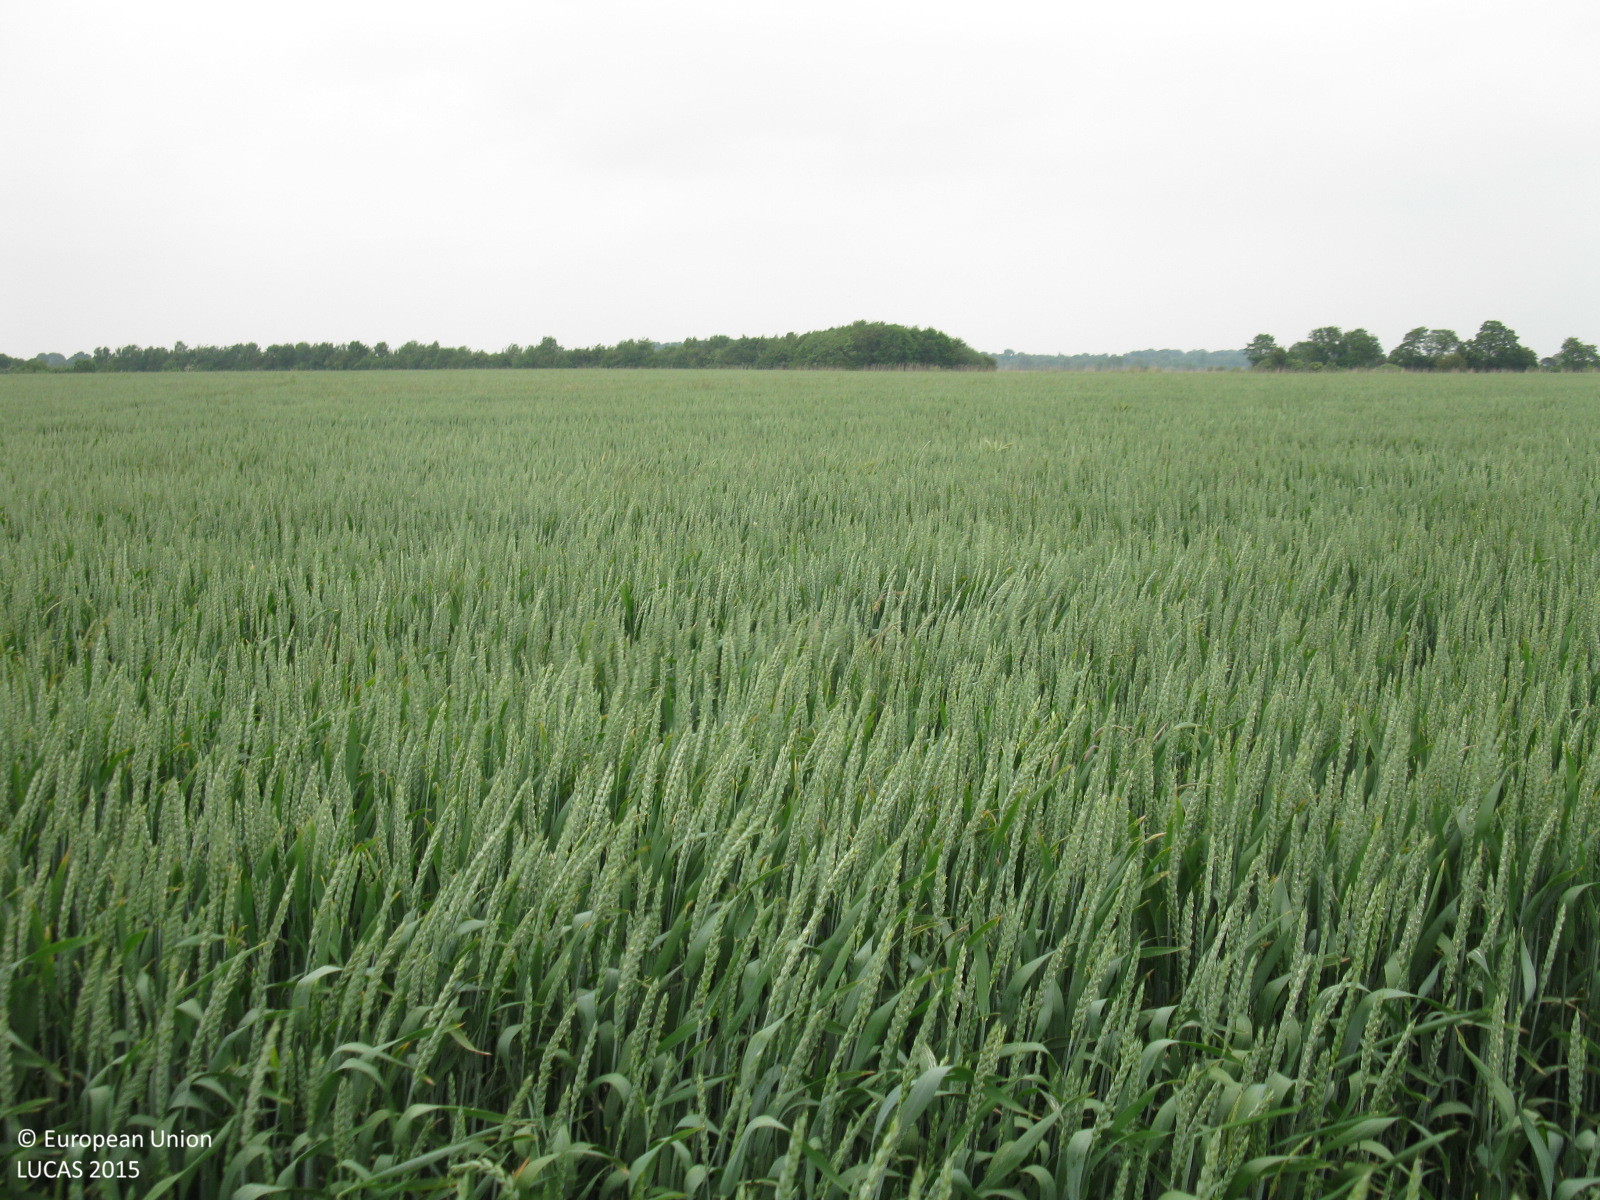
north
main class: Cropland
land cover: Common wheat
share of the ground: > 75 %
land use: Agriculture (excluding fallow land and kitchen gardens)
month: June
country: DE
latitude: 53.4971
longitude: 7.2722
